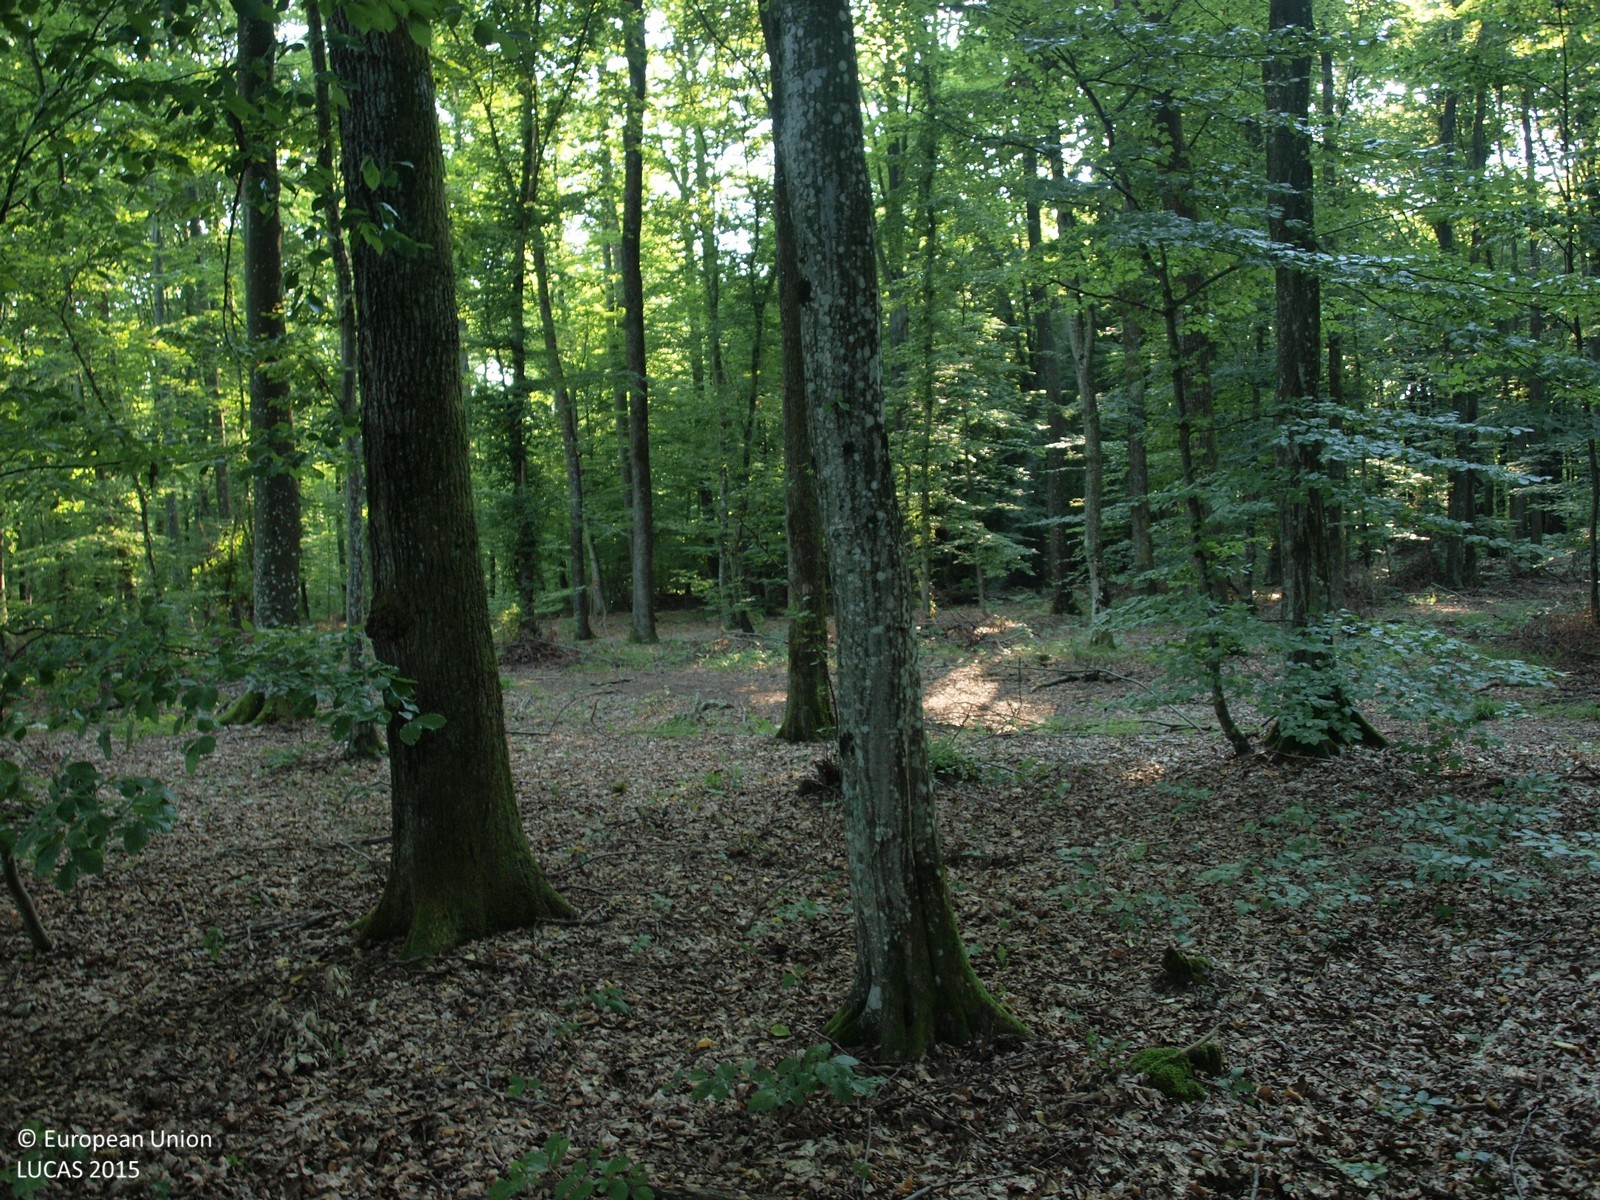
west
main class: Woodland
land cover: Broadleaved woodland
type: mesophytic deciduous forest
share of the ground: > 75 %
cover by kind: broadleaved forest trees 100 %
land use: Forestry
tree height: > 5 m
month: August
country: HR
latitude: 45.8609
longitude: 16.5555
